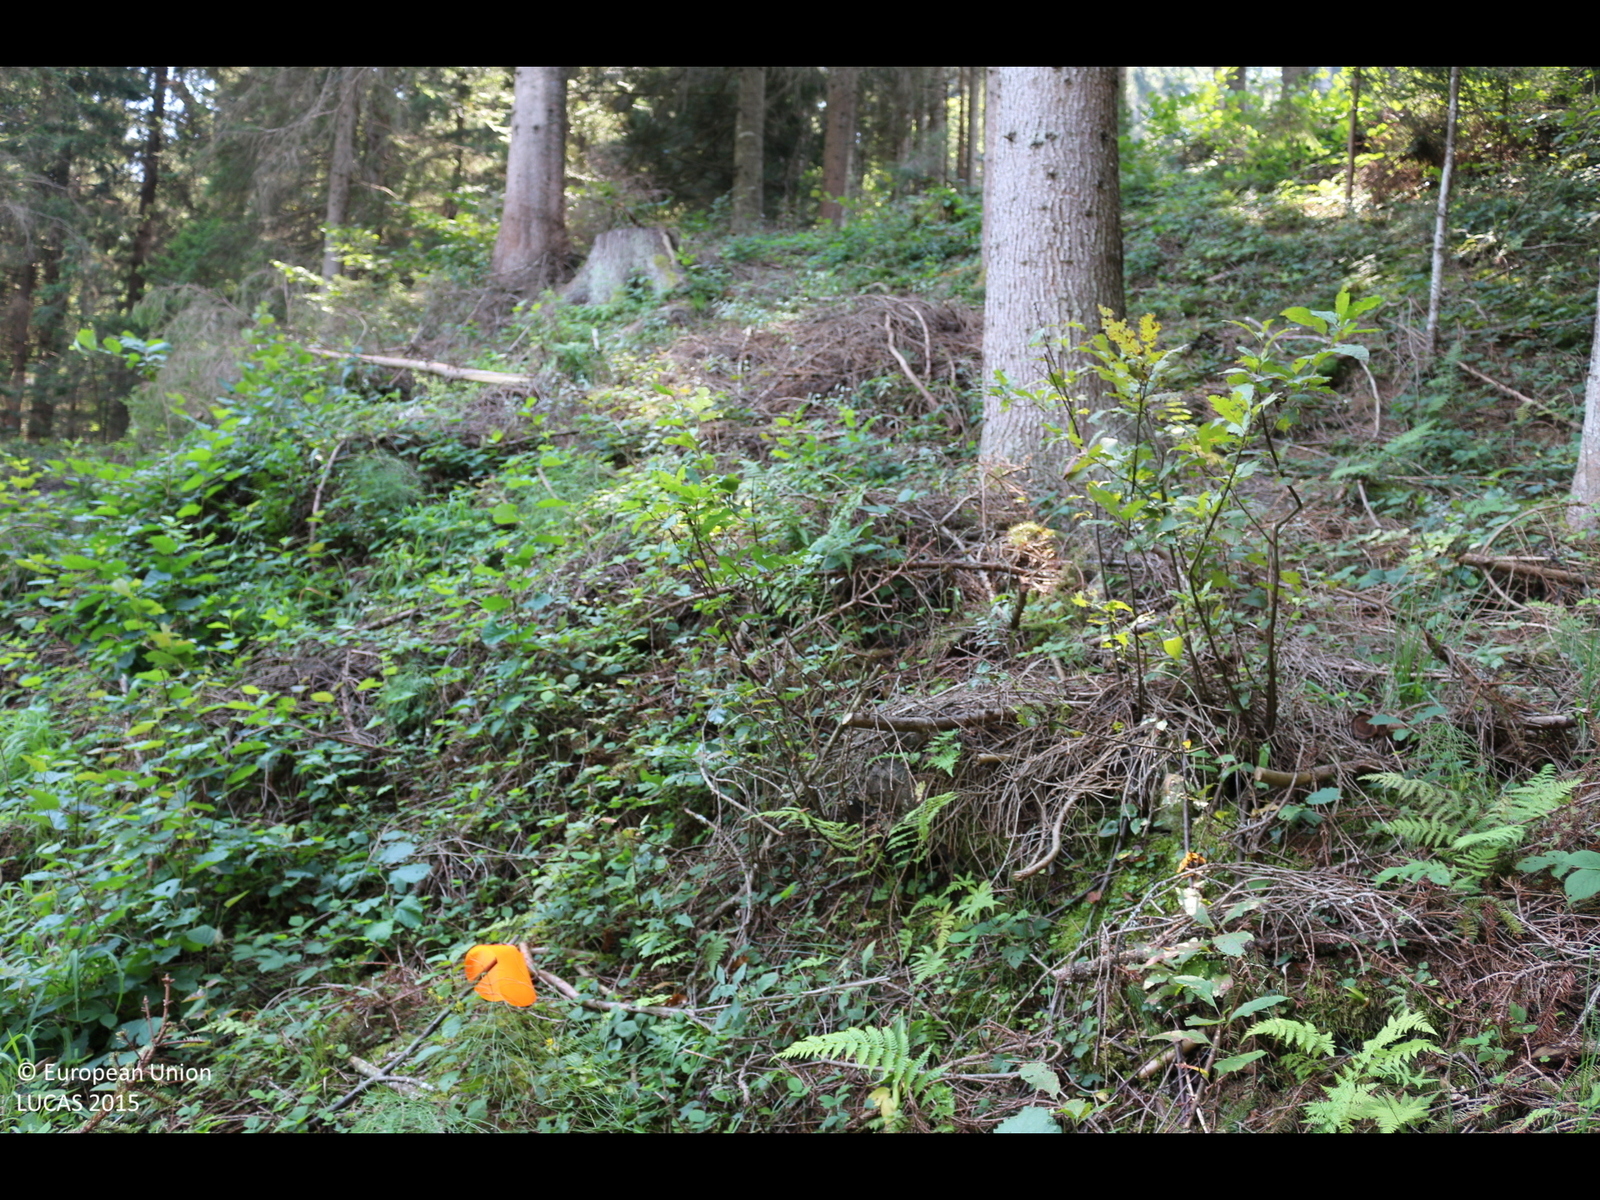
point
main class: Woodland
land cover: Spruce dominated coniferous woodland
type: alpine coniferous forest
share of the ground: > 75 %
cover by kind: coniferous forest trees 85 %, herbaceous plants 10 %, shrubs 5 %
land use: Forestry
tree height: > 5 m
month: August
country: AT
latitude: 46.6607
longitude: 13.3036
